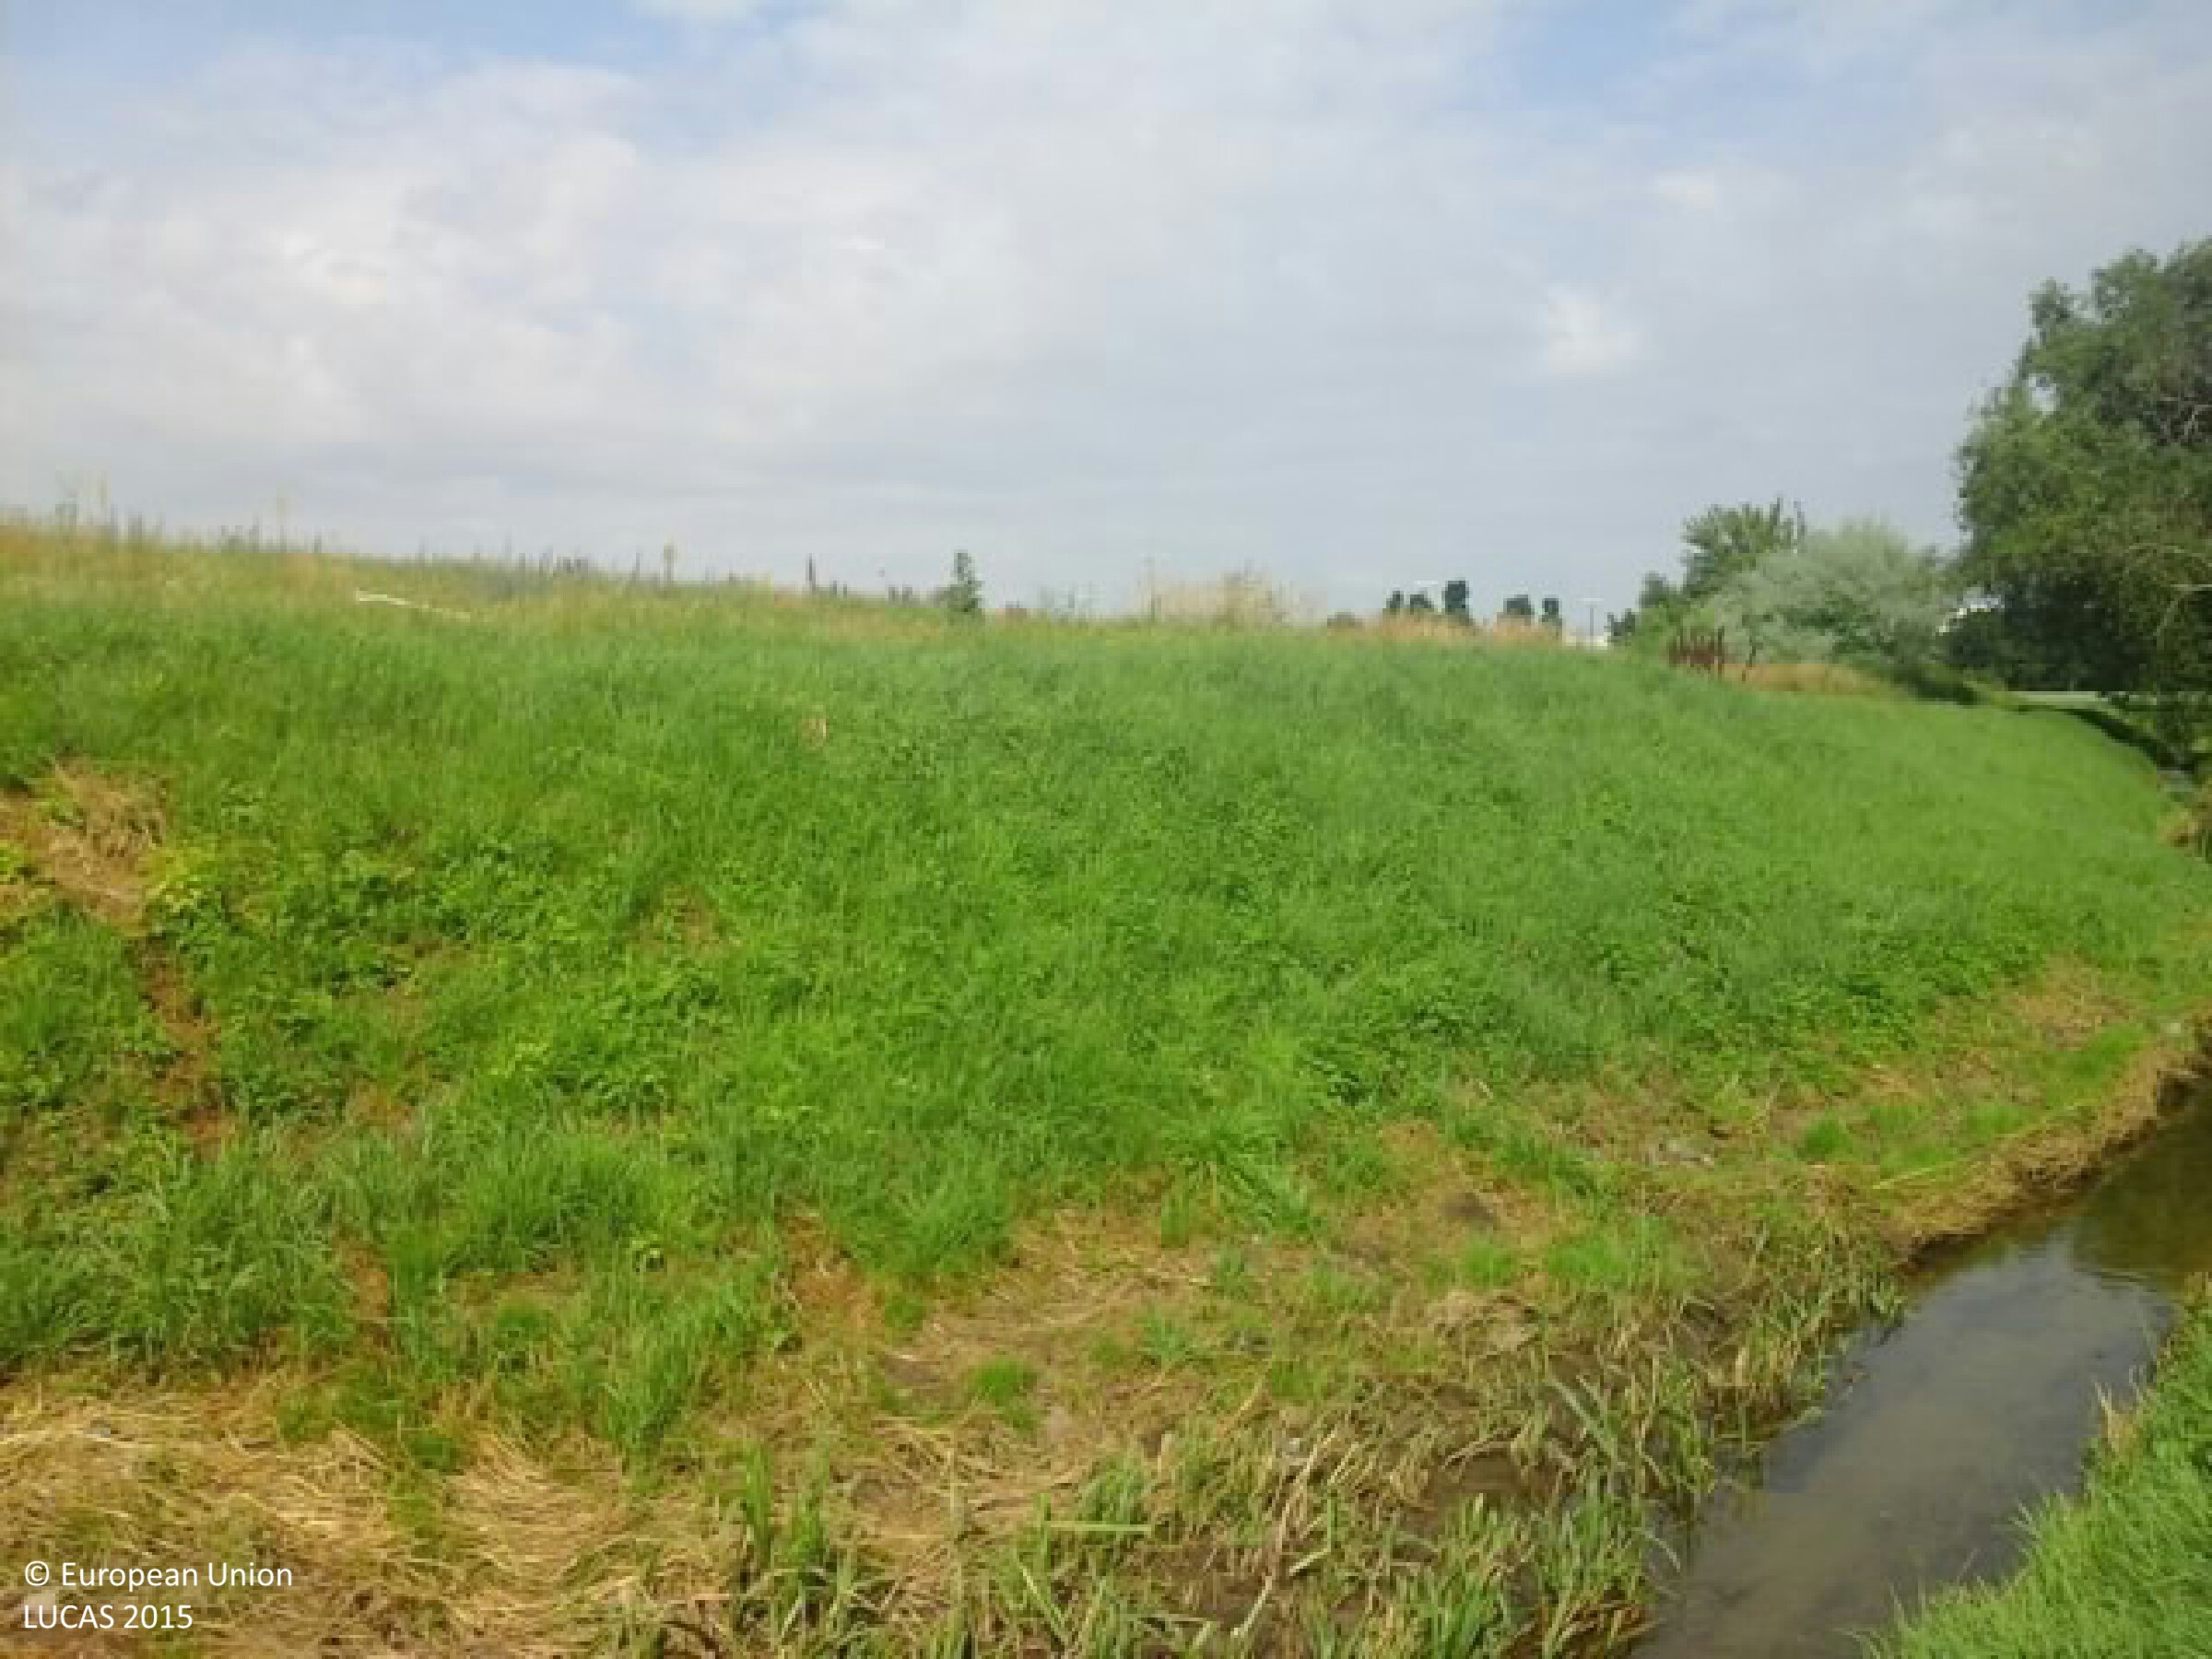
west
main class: Grassland
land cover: Grassland without tree/shrub cover
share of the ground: > 75 %
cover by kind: herbaceous plants 100 %
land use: Semi-natural and natural areas not in use
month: June
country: HU
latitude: 47.5528
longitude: 19.1480
